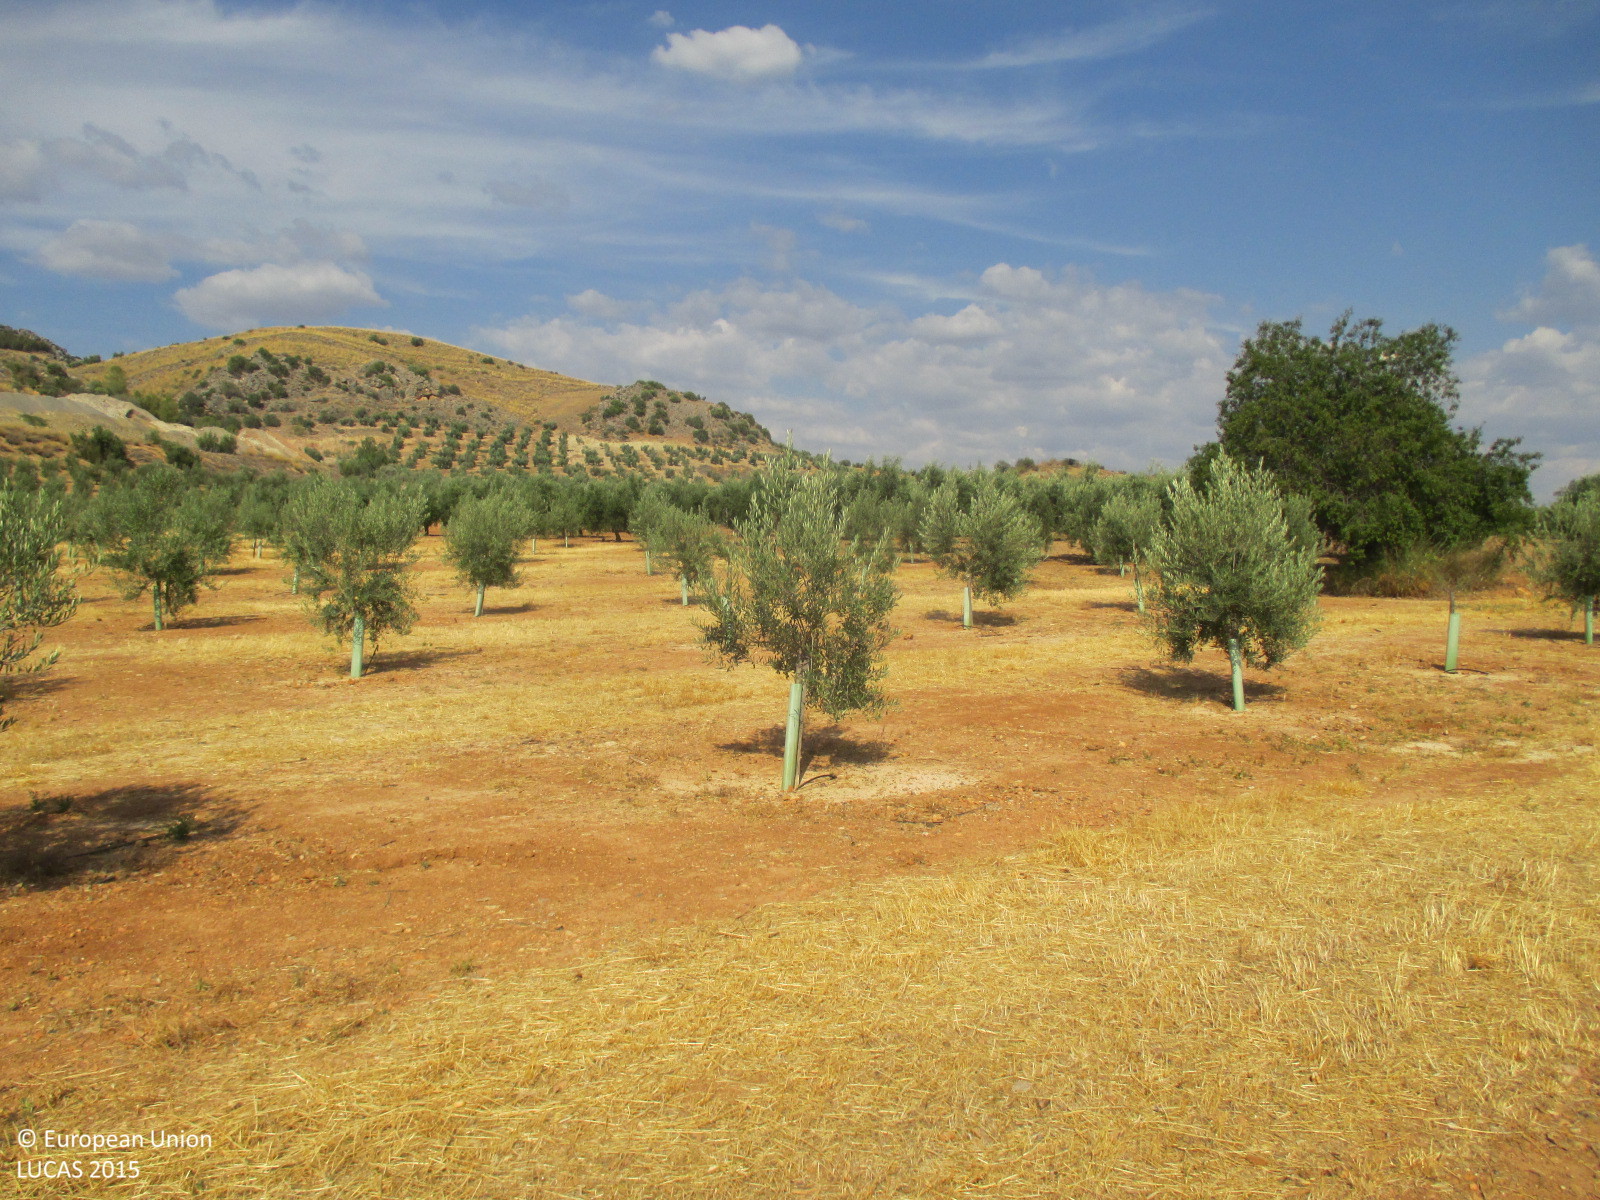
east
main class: Cropland
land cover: Olive groves
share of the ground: < 10 %
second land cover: Spontaneously vegetated surfaces
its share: 10 - 25 %
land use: Agriculture (excluding fallow land and kitchen gardens)
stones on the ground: < 10 %
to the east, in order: Olive groves; Spontaneously vegetated surfaces; Tracks; Olive groves; Grass margins; Olive groves; Grass margins; Tracks; Grass margins; Olive groves
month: June
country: ES
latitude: 37.5881
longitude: -4.1234
